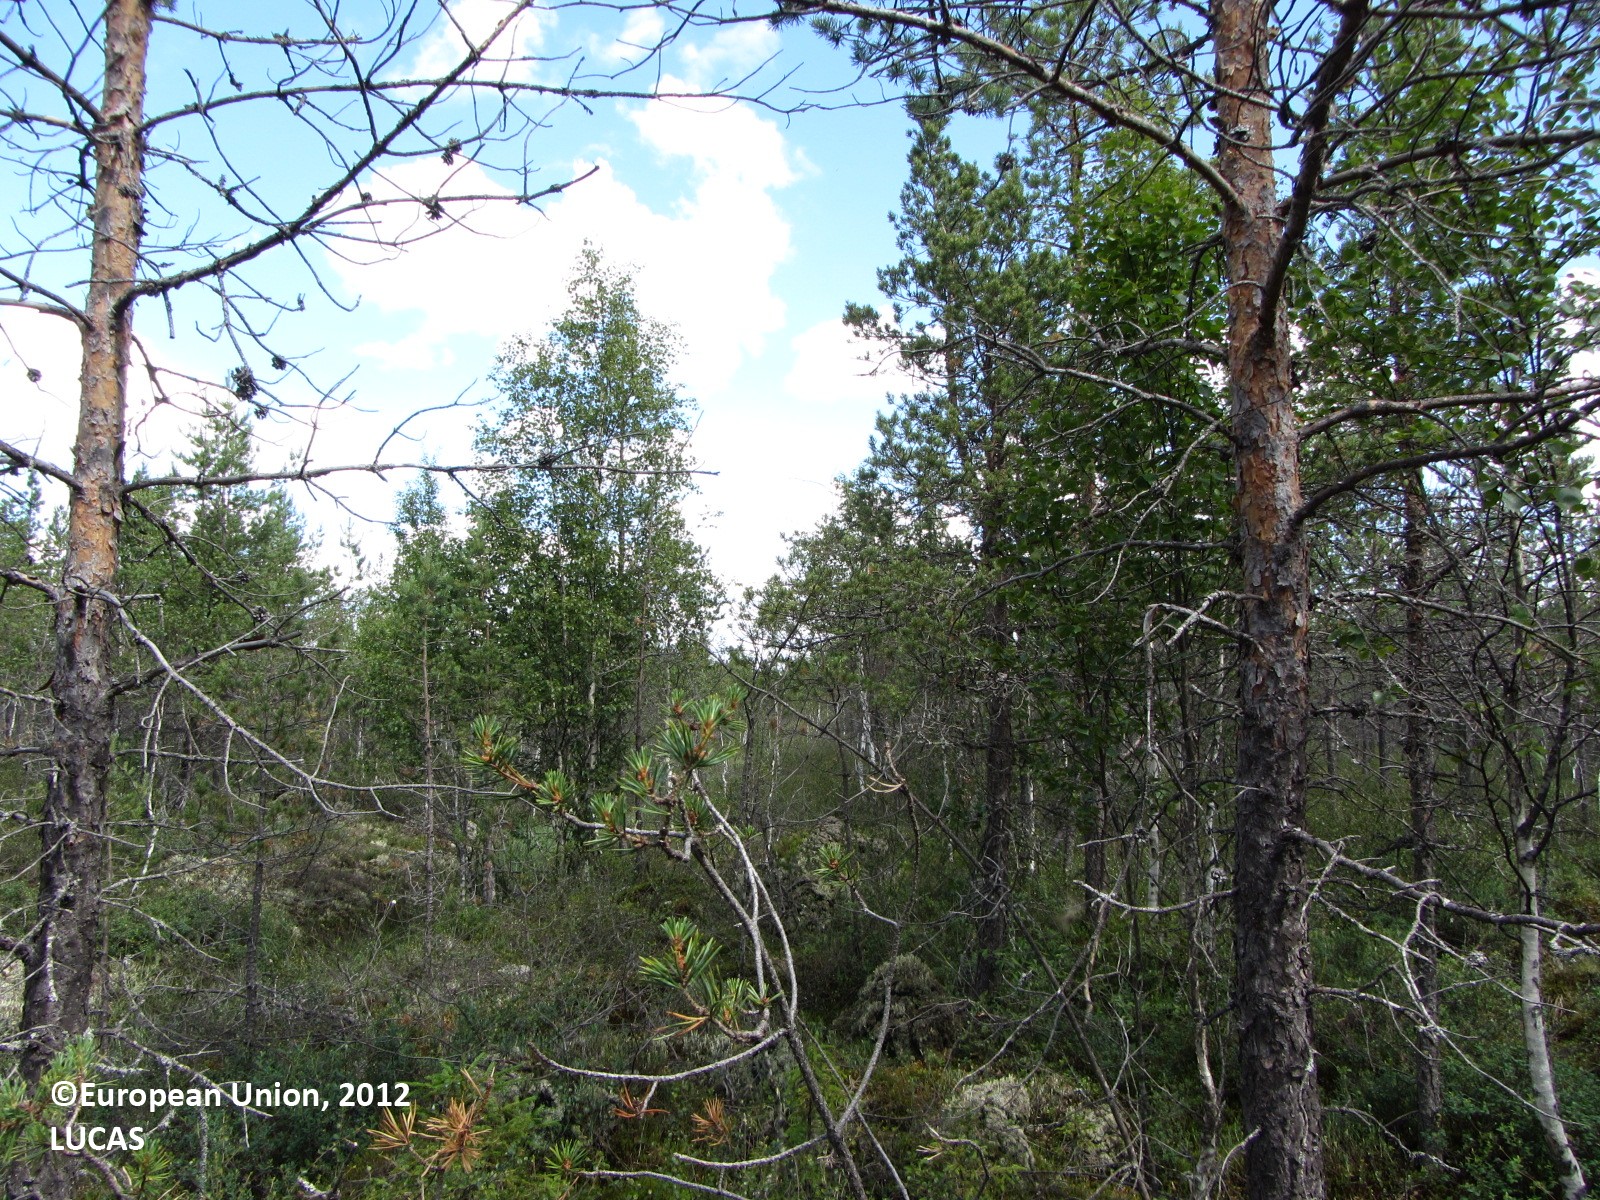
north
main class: Woodland
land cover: Pine dominated coniferous woodland
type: boreal forest
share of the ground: 50 - 75 %
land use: Forestry
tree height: > 5 m
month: July
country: FI
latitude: 63.6866
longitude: 25.4863
